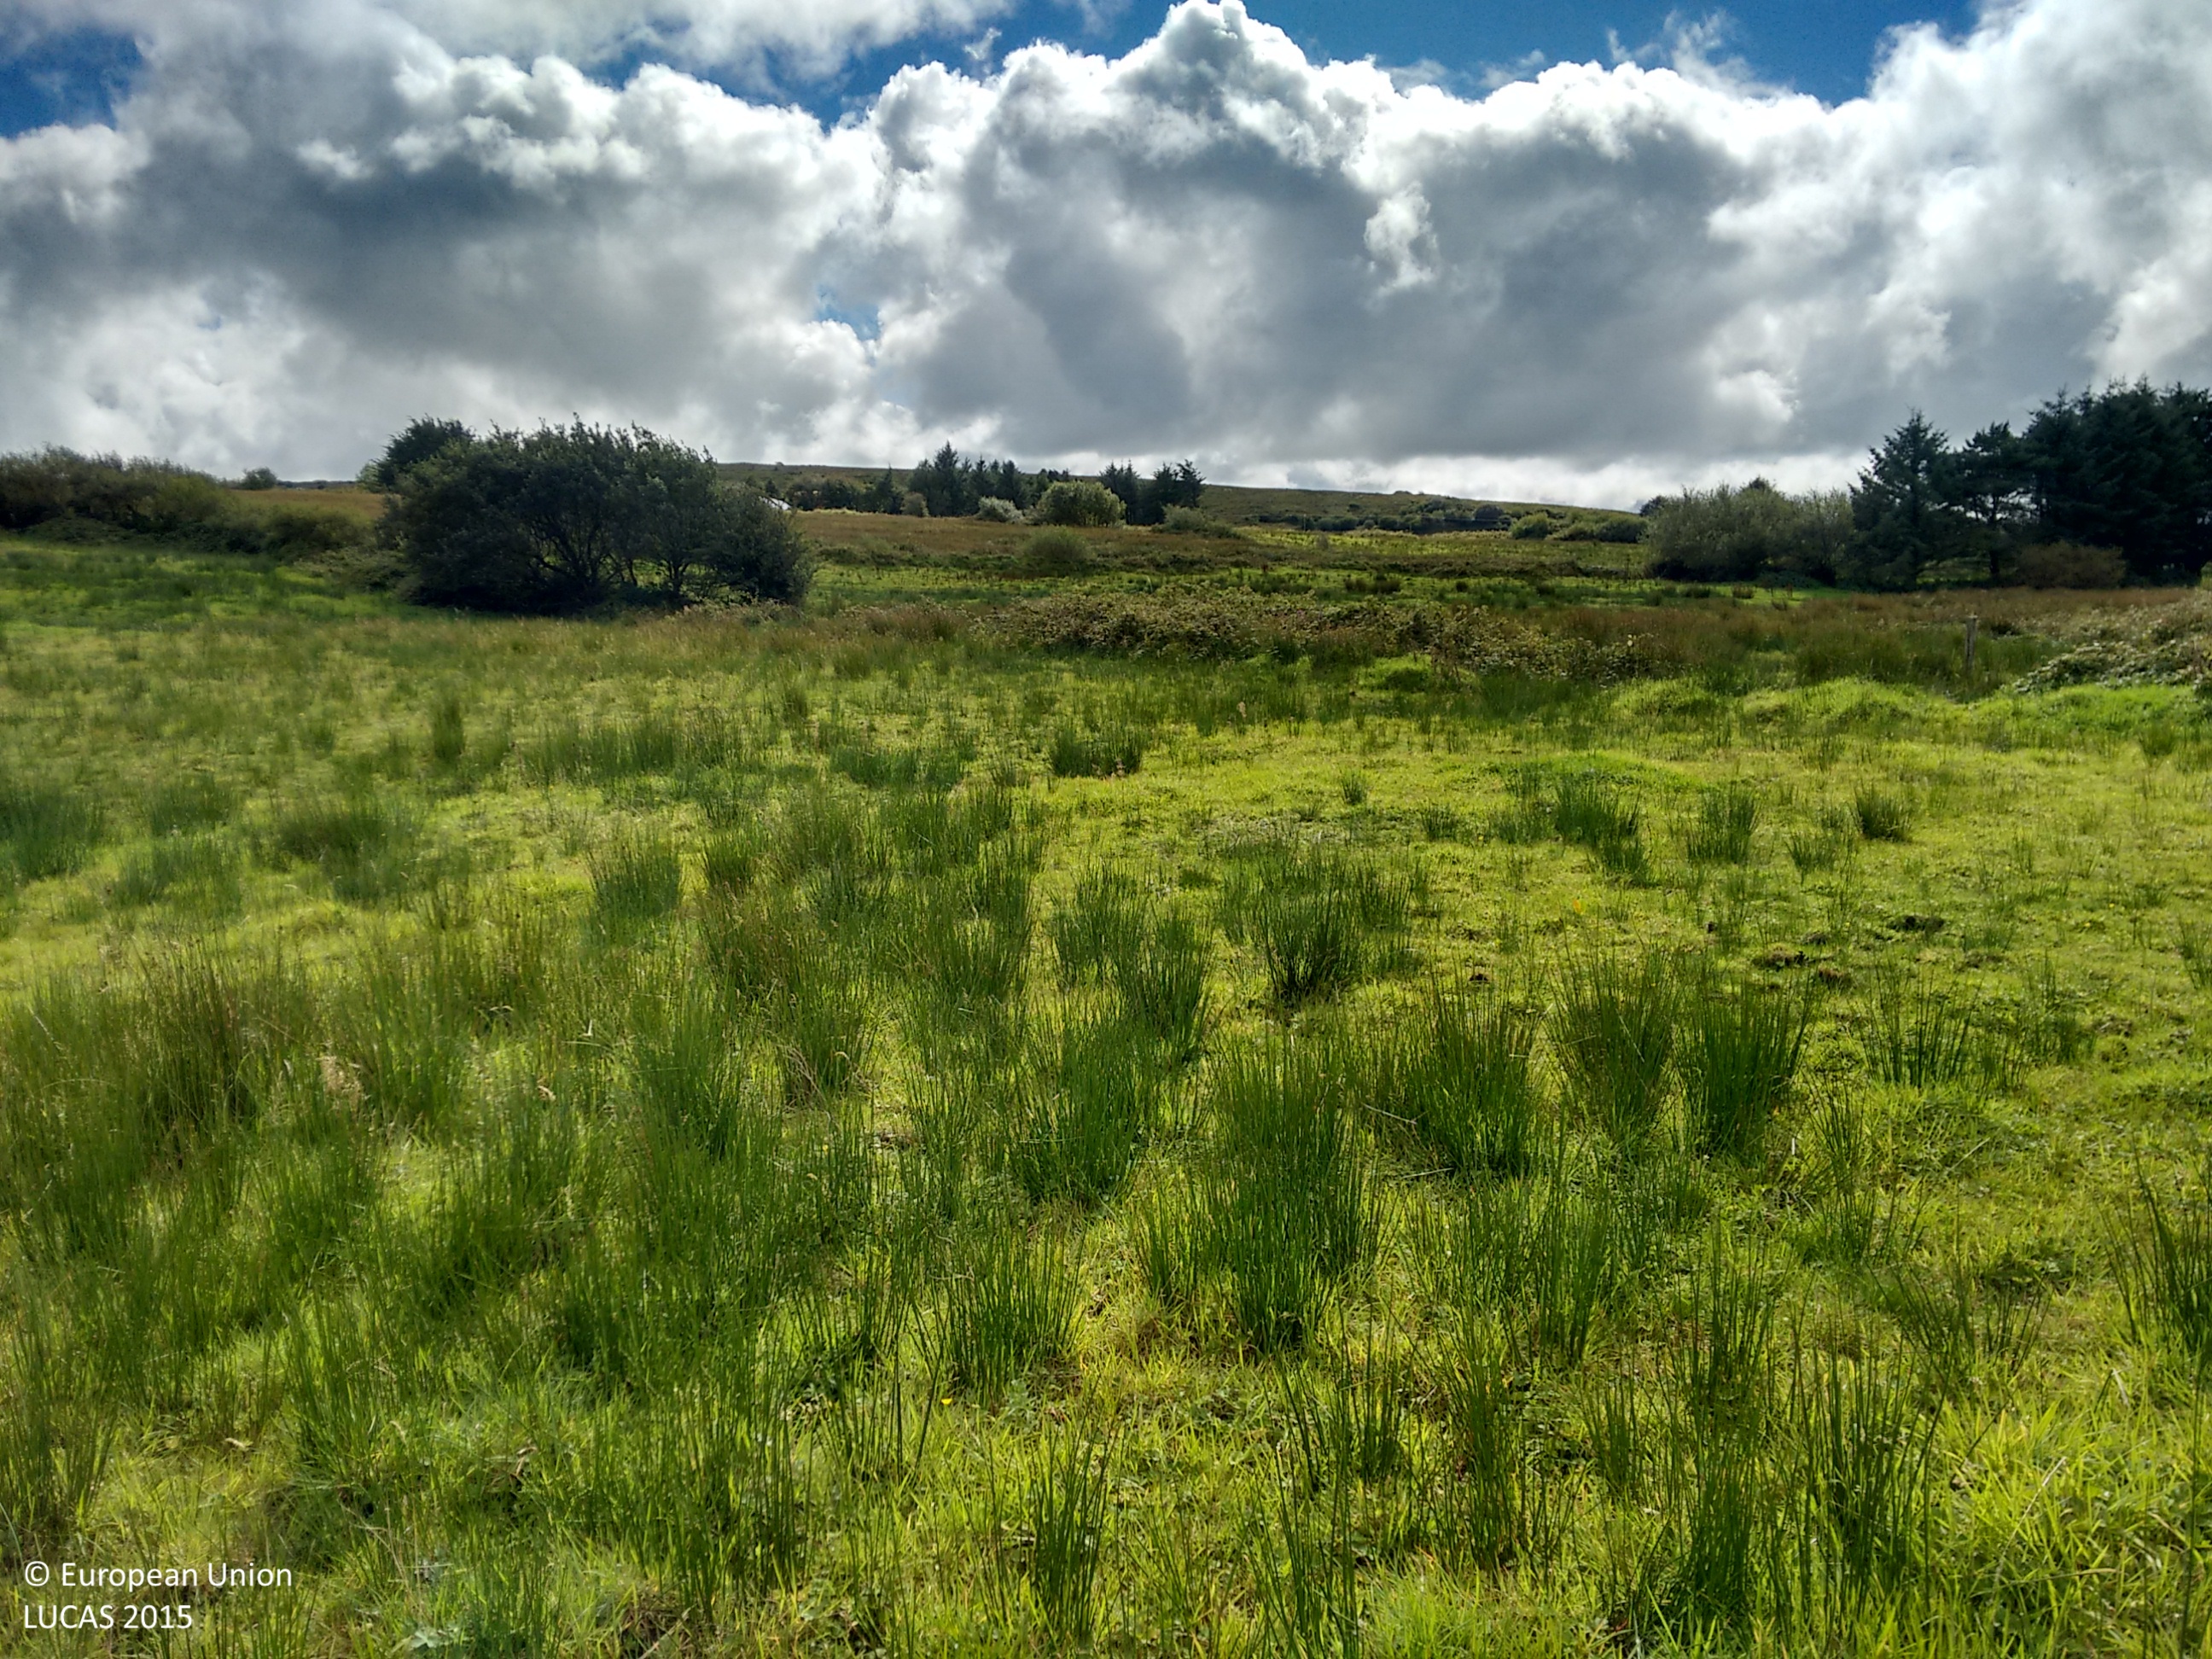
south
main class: Grassland
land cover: Grassland without tree/shrub cover
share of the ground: > 75 %
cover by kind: herbaceous plants 95 %
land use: Agriculture (excluding fallow land and kitchen gardens)
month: September
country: IE
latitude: 52.9201
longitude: -9.1834
